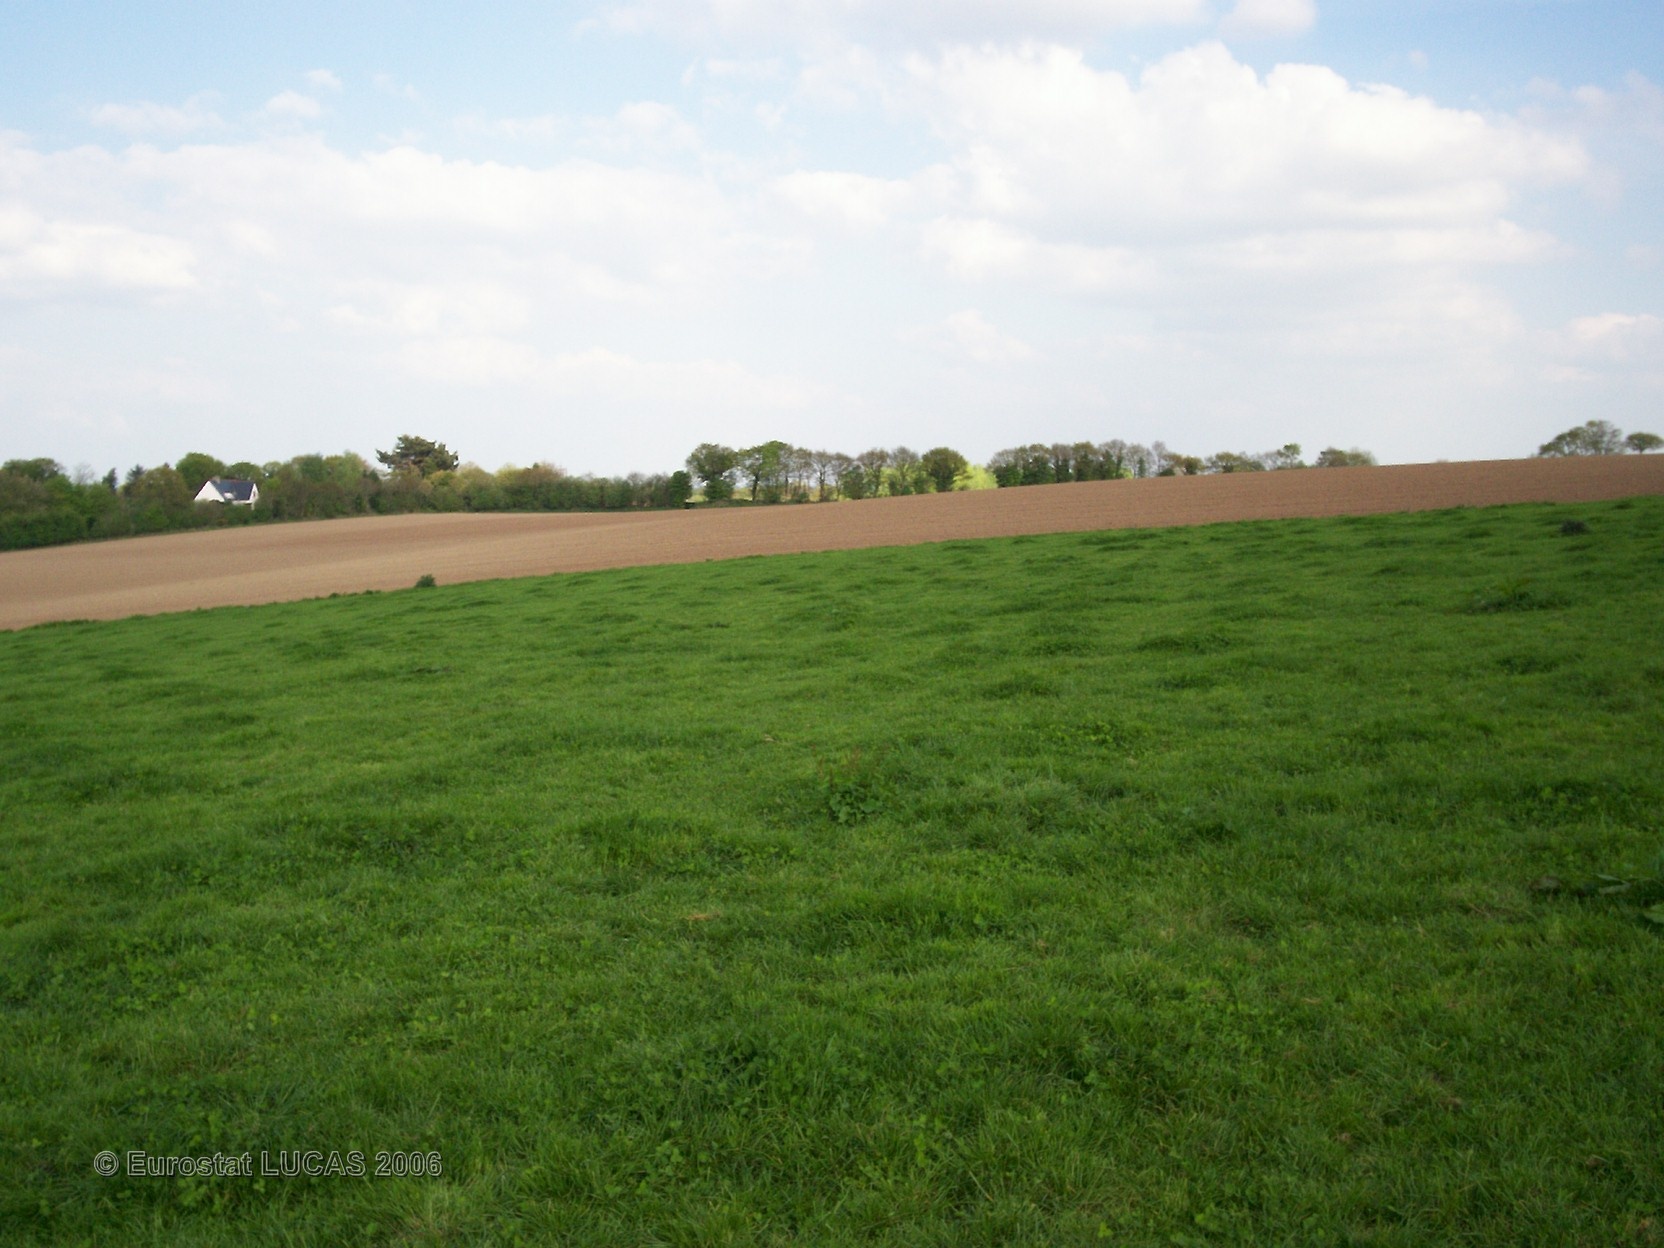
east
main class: Grassland
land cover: Grassland without tree/shrub cover
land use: Agriculture (excluding fallow land and kitchen gardens)
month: May
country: FR
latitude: 48.3413
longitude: -3.6125
